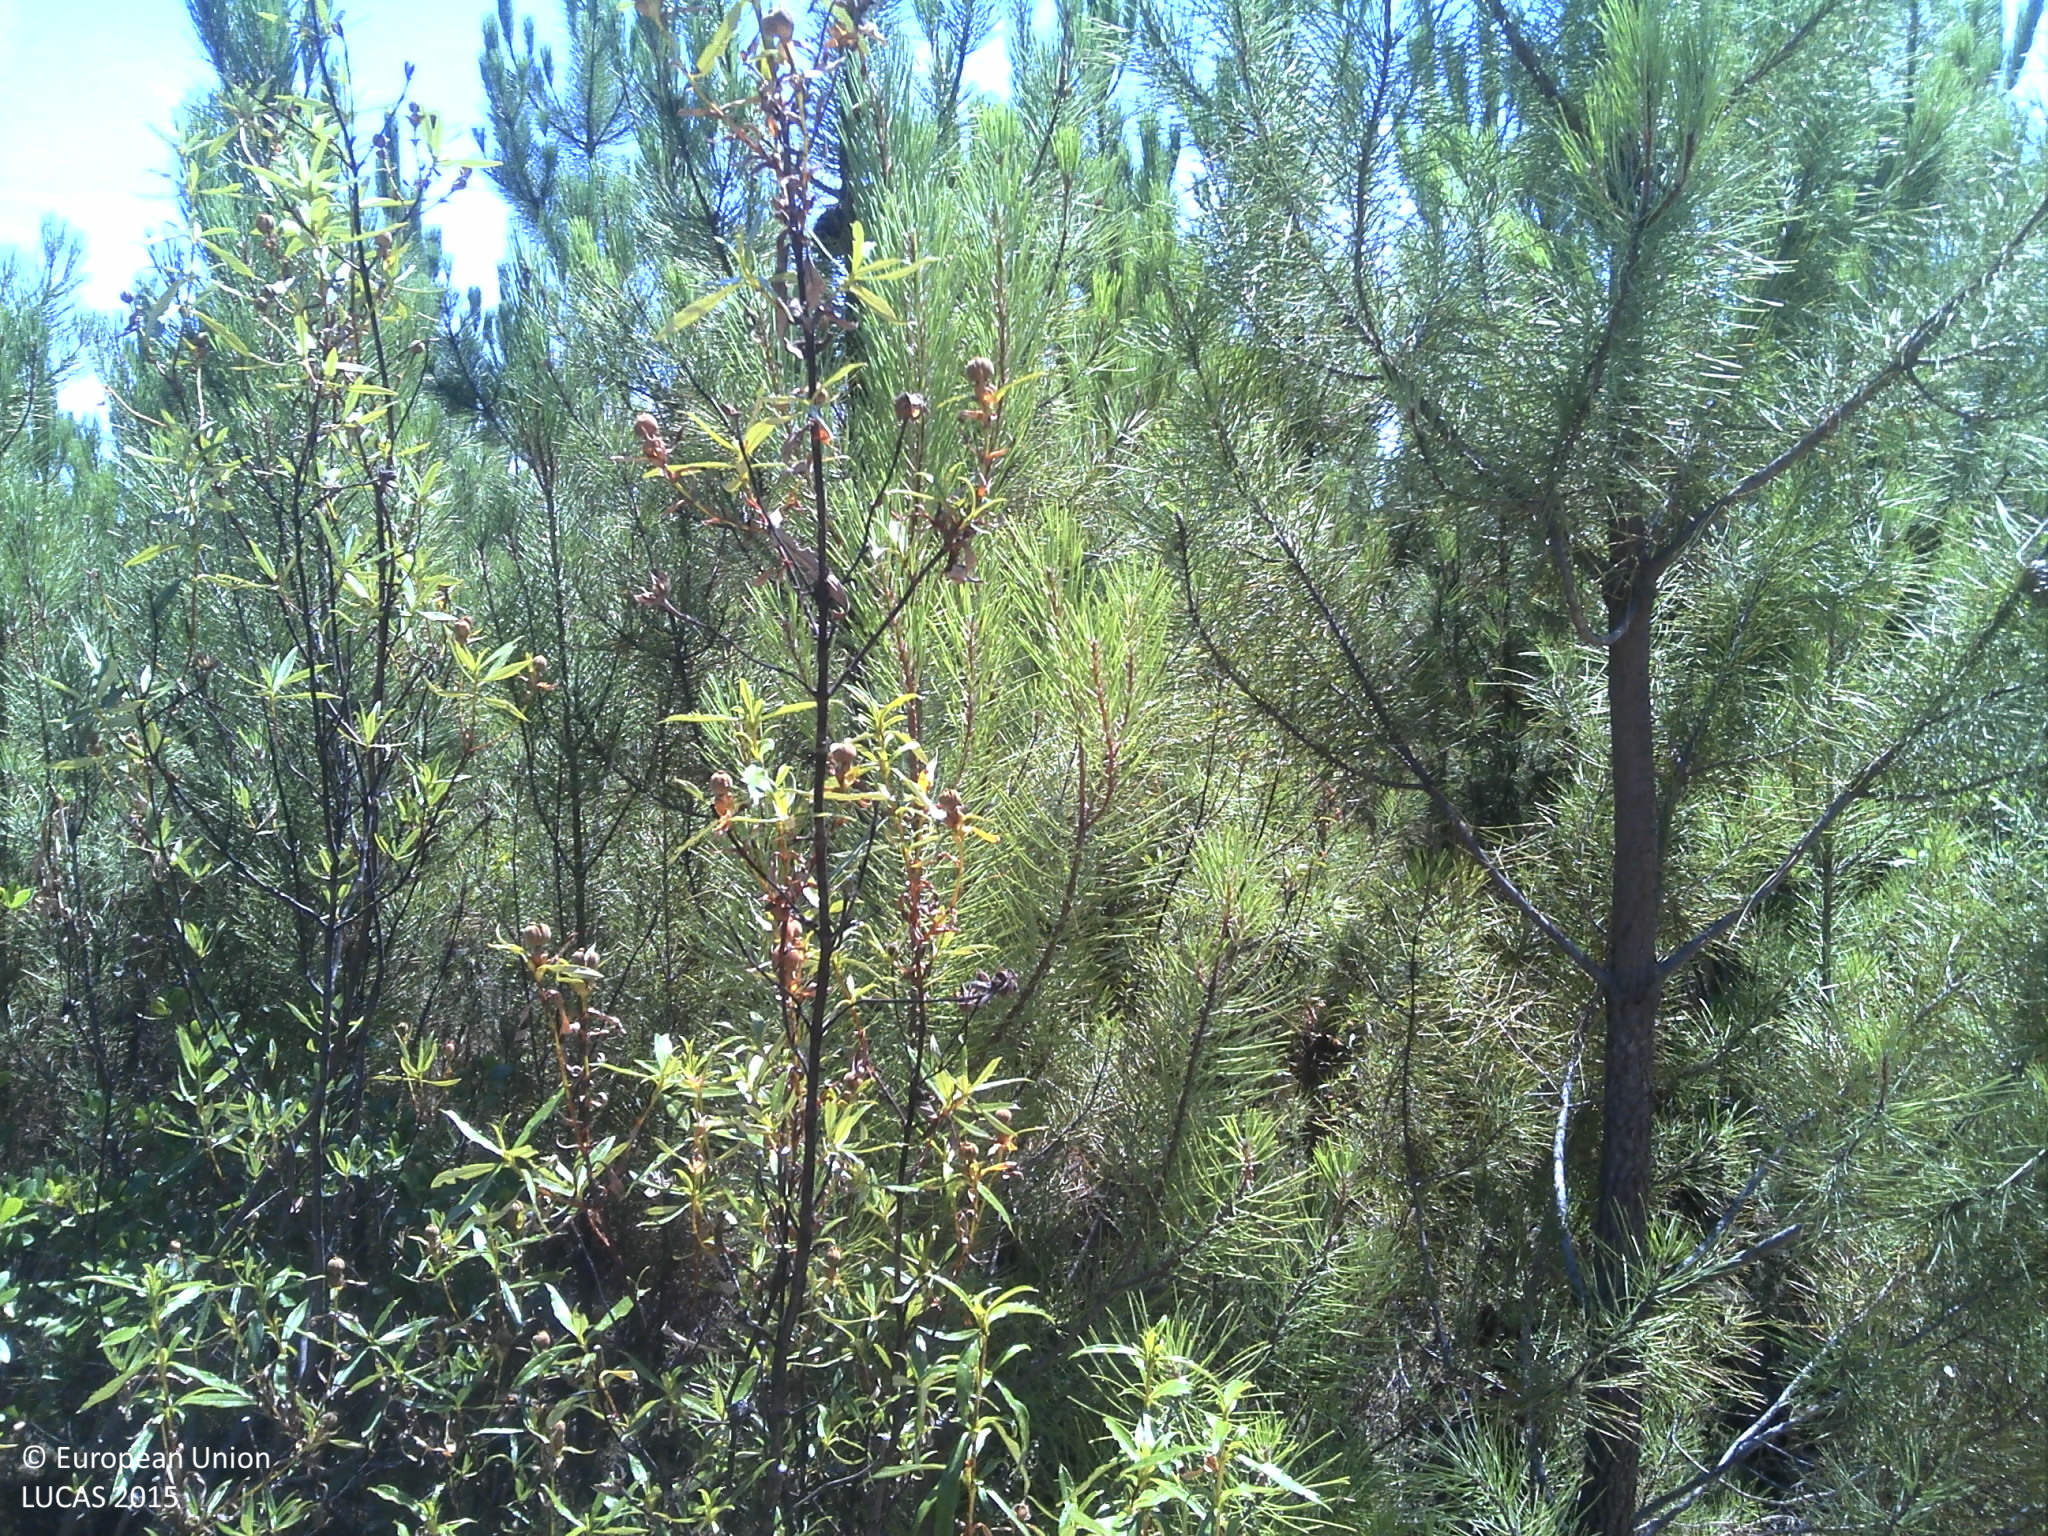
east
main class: Woodland
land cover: Pine dominated coniferous woodland
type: coniferous forest of the mediterranean region
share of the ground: 50 - 75 %
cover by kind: coniferous forest trees 70 %, shrubs 25 %
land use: Forestry
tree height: > 5 m
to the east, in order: Pine dominated coniferous woodland; Tracks; Pine dominated coniferous woodland; Shrubland without tree cover; Artificial constructions in urban areas; Shrubland with sparse tree cover; Tracks; Broadleaved woodland
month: July
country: PT
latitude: 40.0480
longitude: -7.8947
